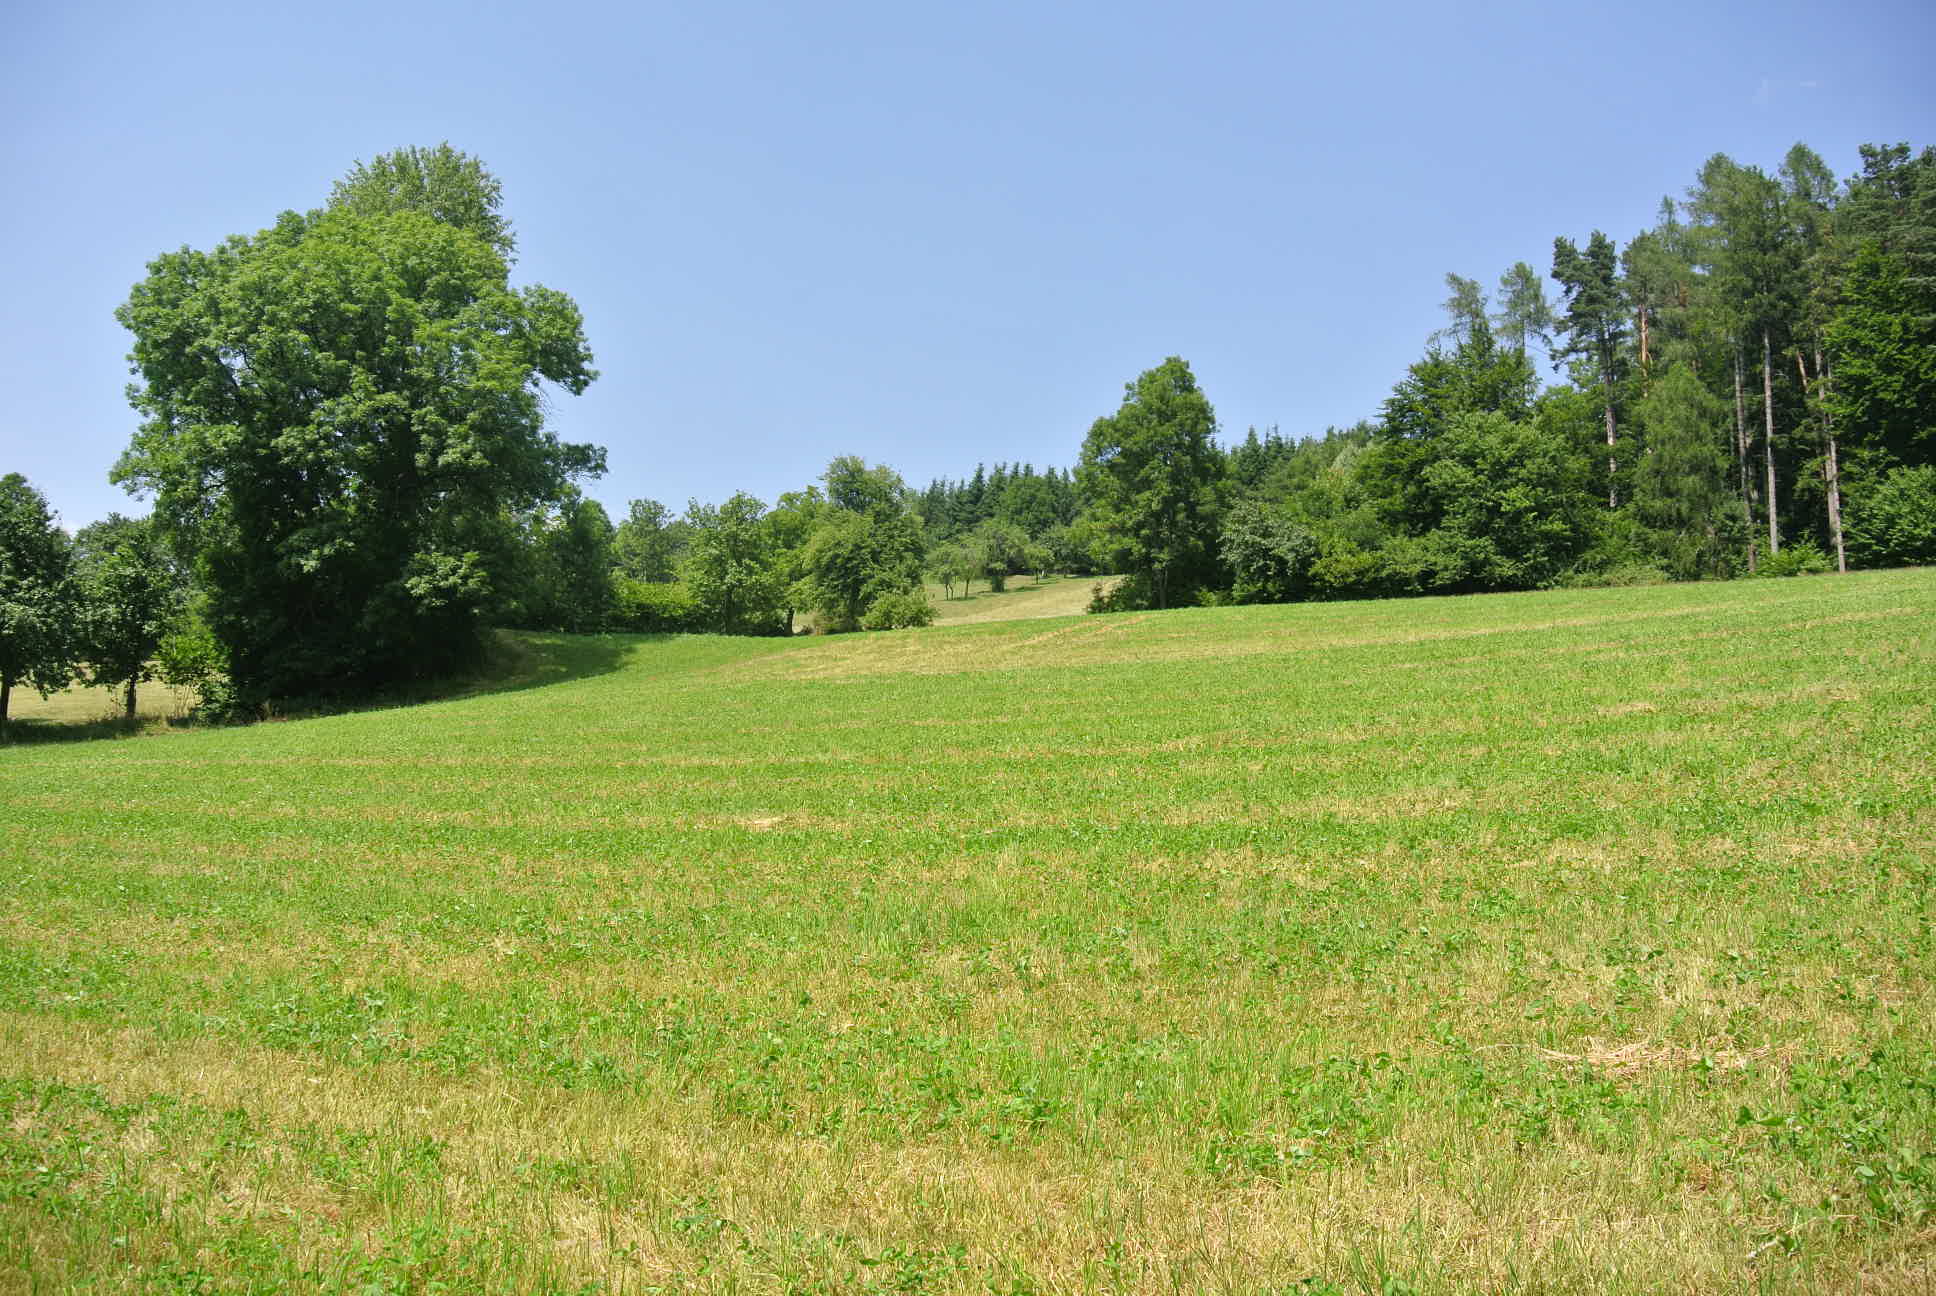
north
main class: Grassland
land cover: Grassland without tree/shrub cover
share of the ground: > 75 %
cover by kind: herbaceous plants 100 %
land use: Agriculture (excluding fallow land and kitchen gardens)
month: July
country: AT
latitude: 47.6179
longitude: 16.1632
